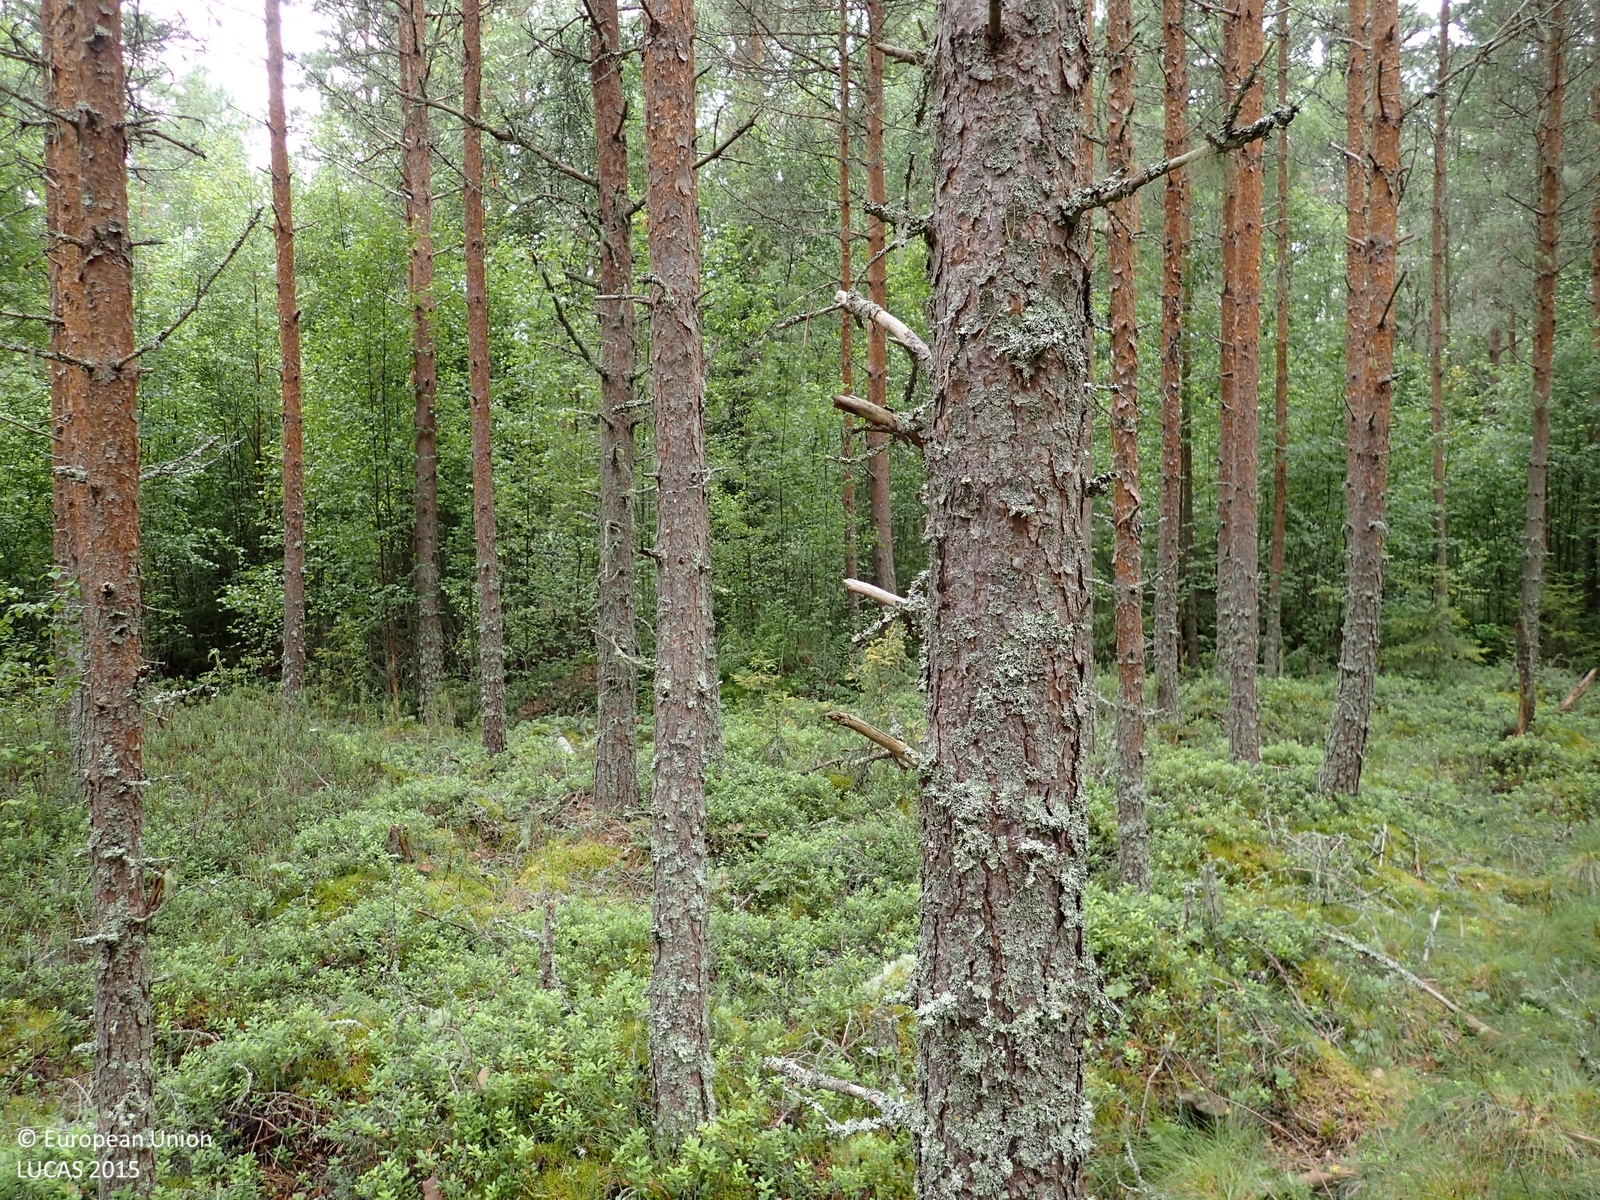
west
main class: Woodland
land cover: Pine dominated coniferous woodland
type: boreal forest
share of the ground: 50 - 75 %
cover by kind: coniferous forest trees 45 %, shrubs 40 %, lichens and mosses 10 %, broadleaved forest trees 5 %
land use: Forestry
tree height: > 5 m
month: August
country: FI
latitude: 62.9053
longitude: 21.9119
